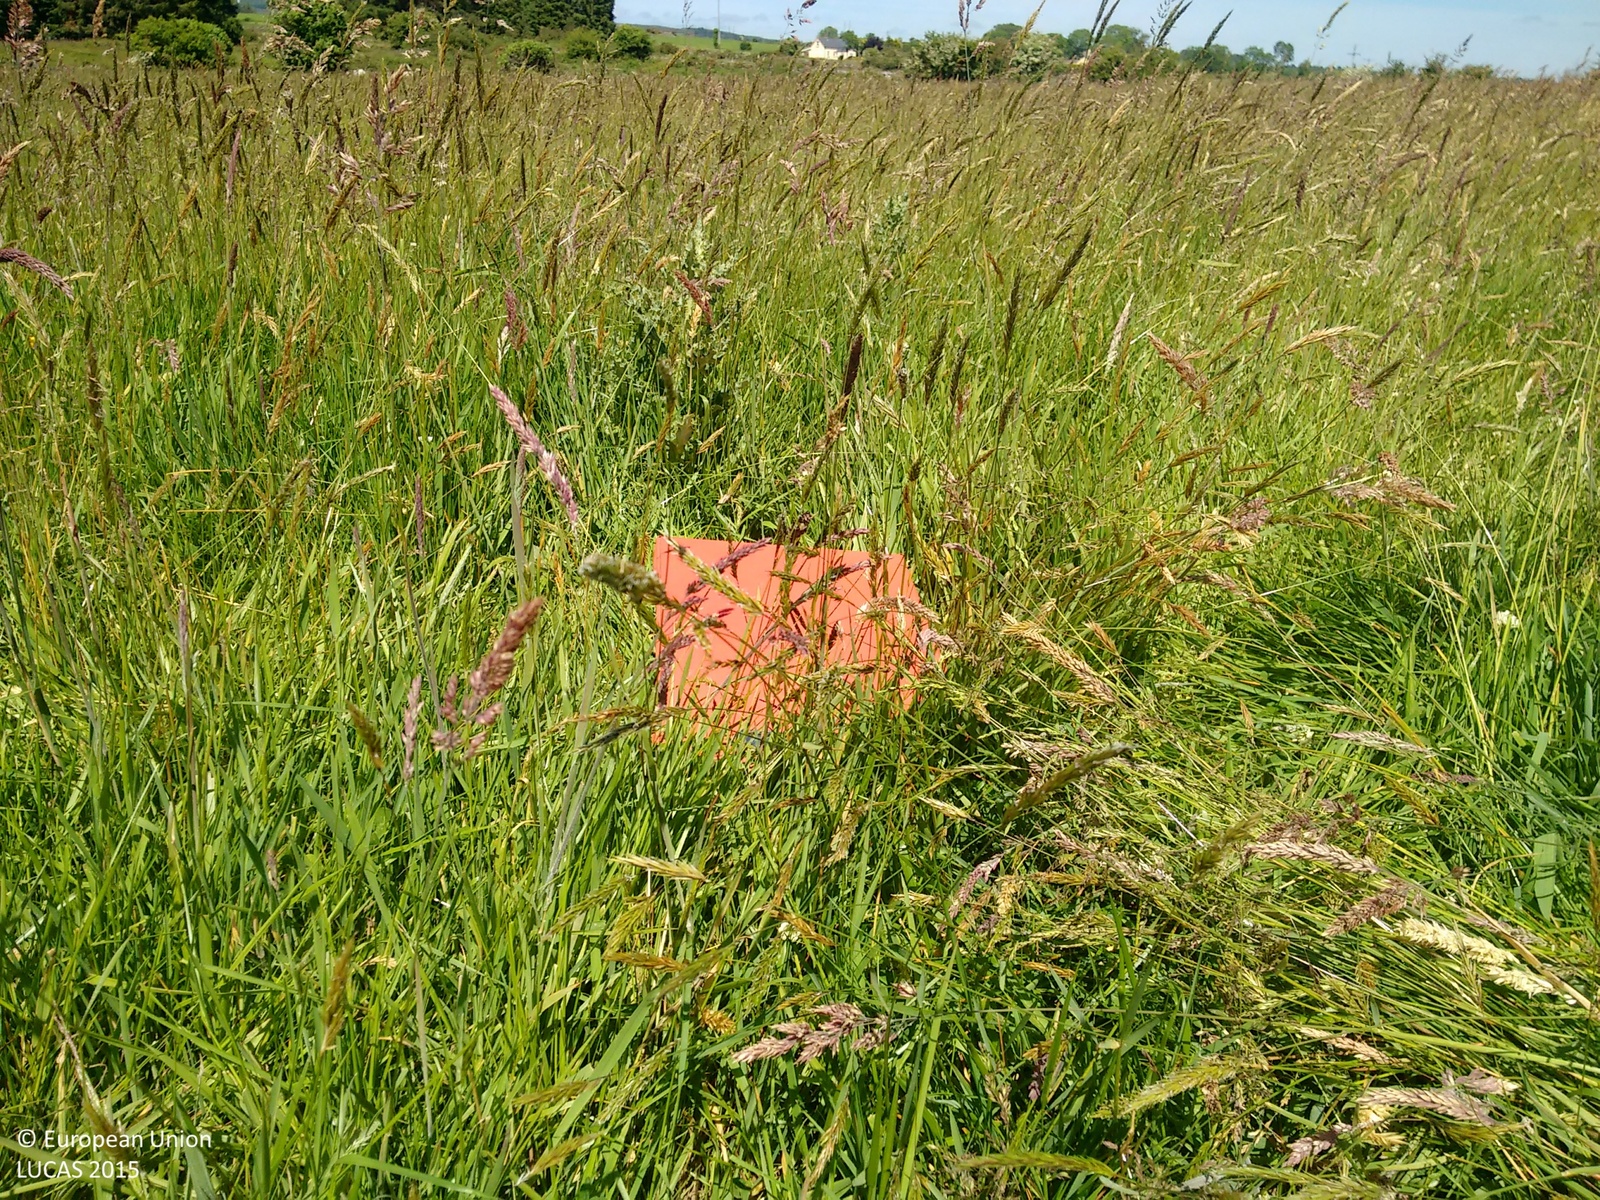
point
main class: Grassland
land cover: Grassland without tree/shrub cover
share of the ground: > 75 %
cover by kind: herbaceous plants 100 %
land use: Agriculture (excluding fallow land and kitchen gardens)
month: June
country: IE
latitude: 51.9254
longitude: -8.9251
